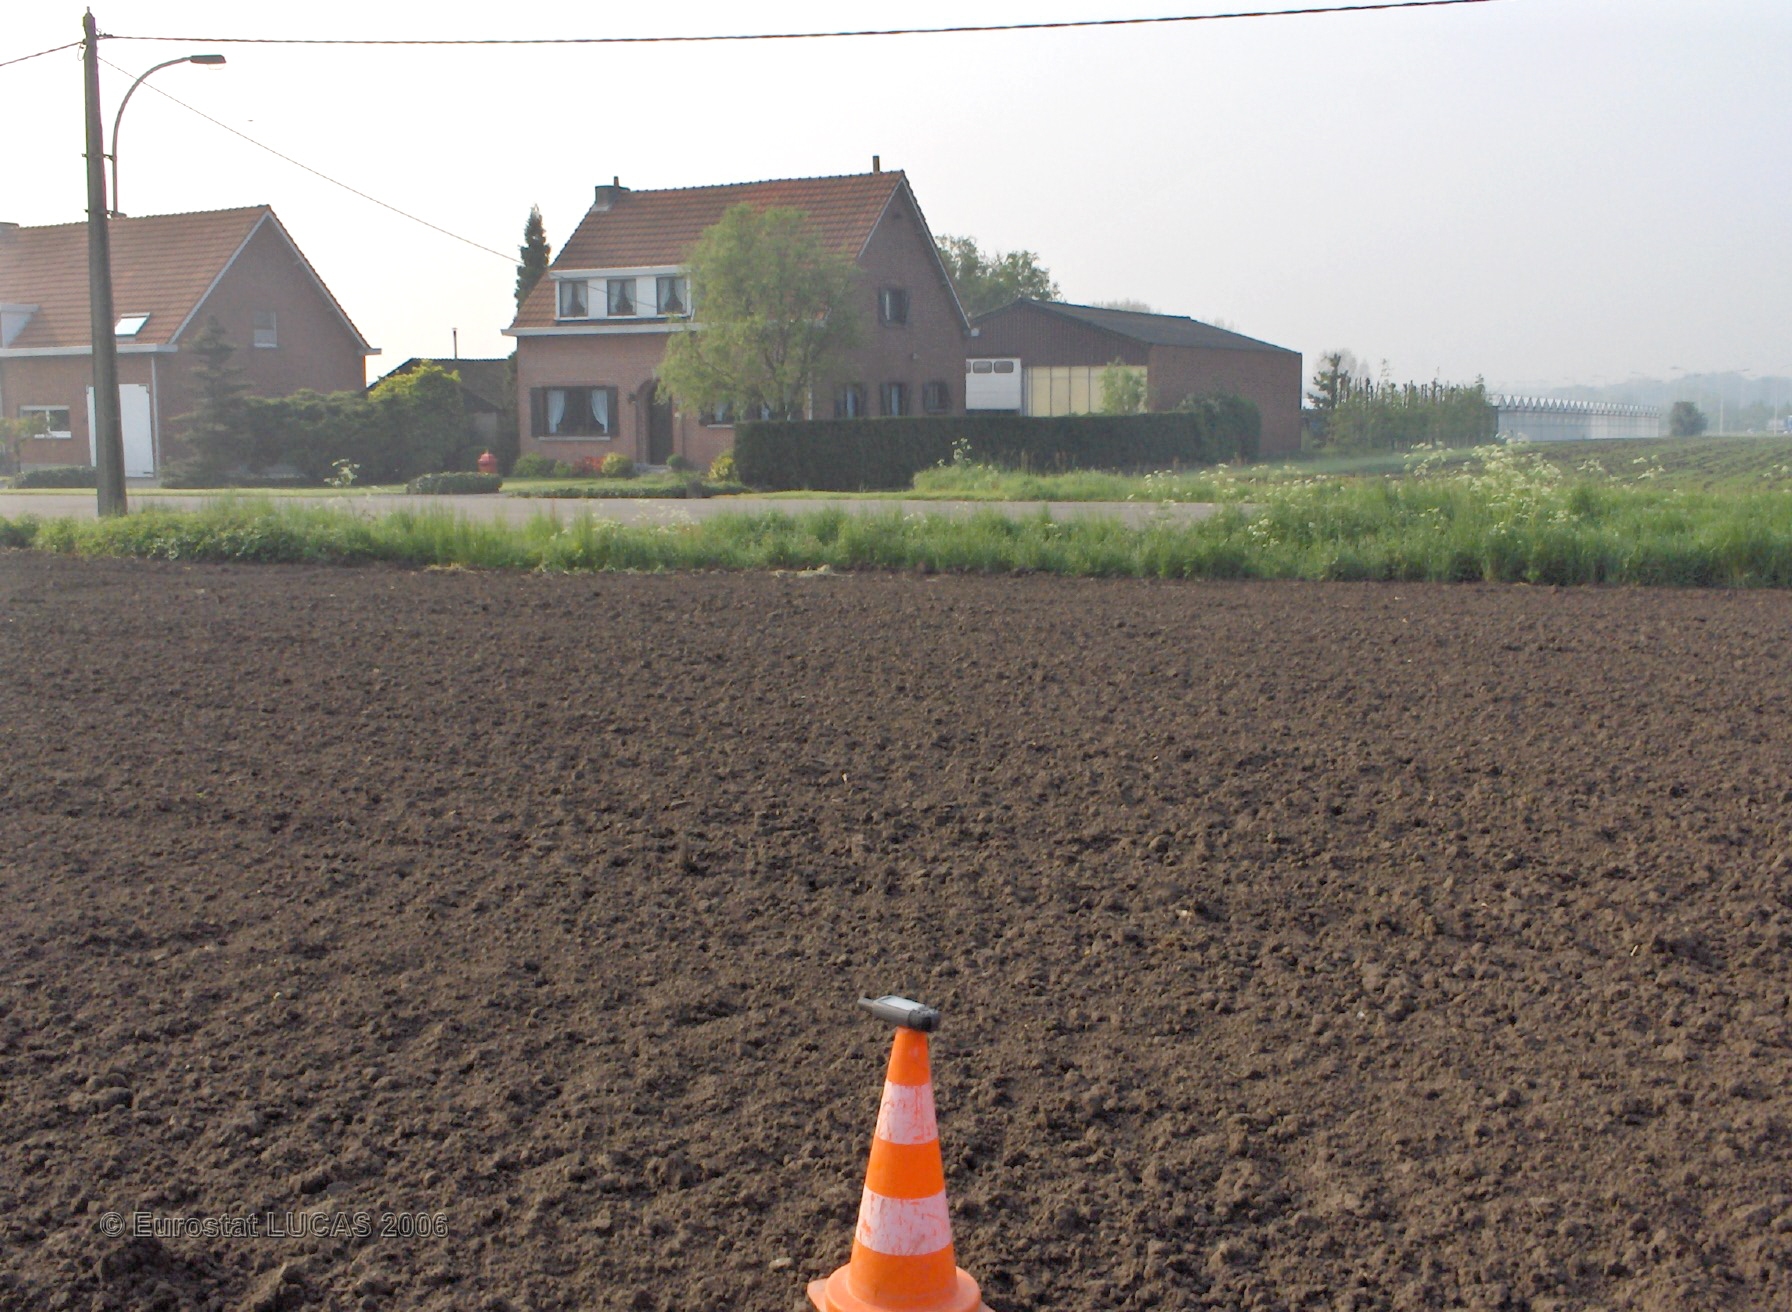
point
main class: Cropland
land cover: Maize
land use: Agriculture (excluding fallow land and kitchen gardens)
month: May
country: BE
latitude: 51.0940
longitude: 4.4412
